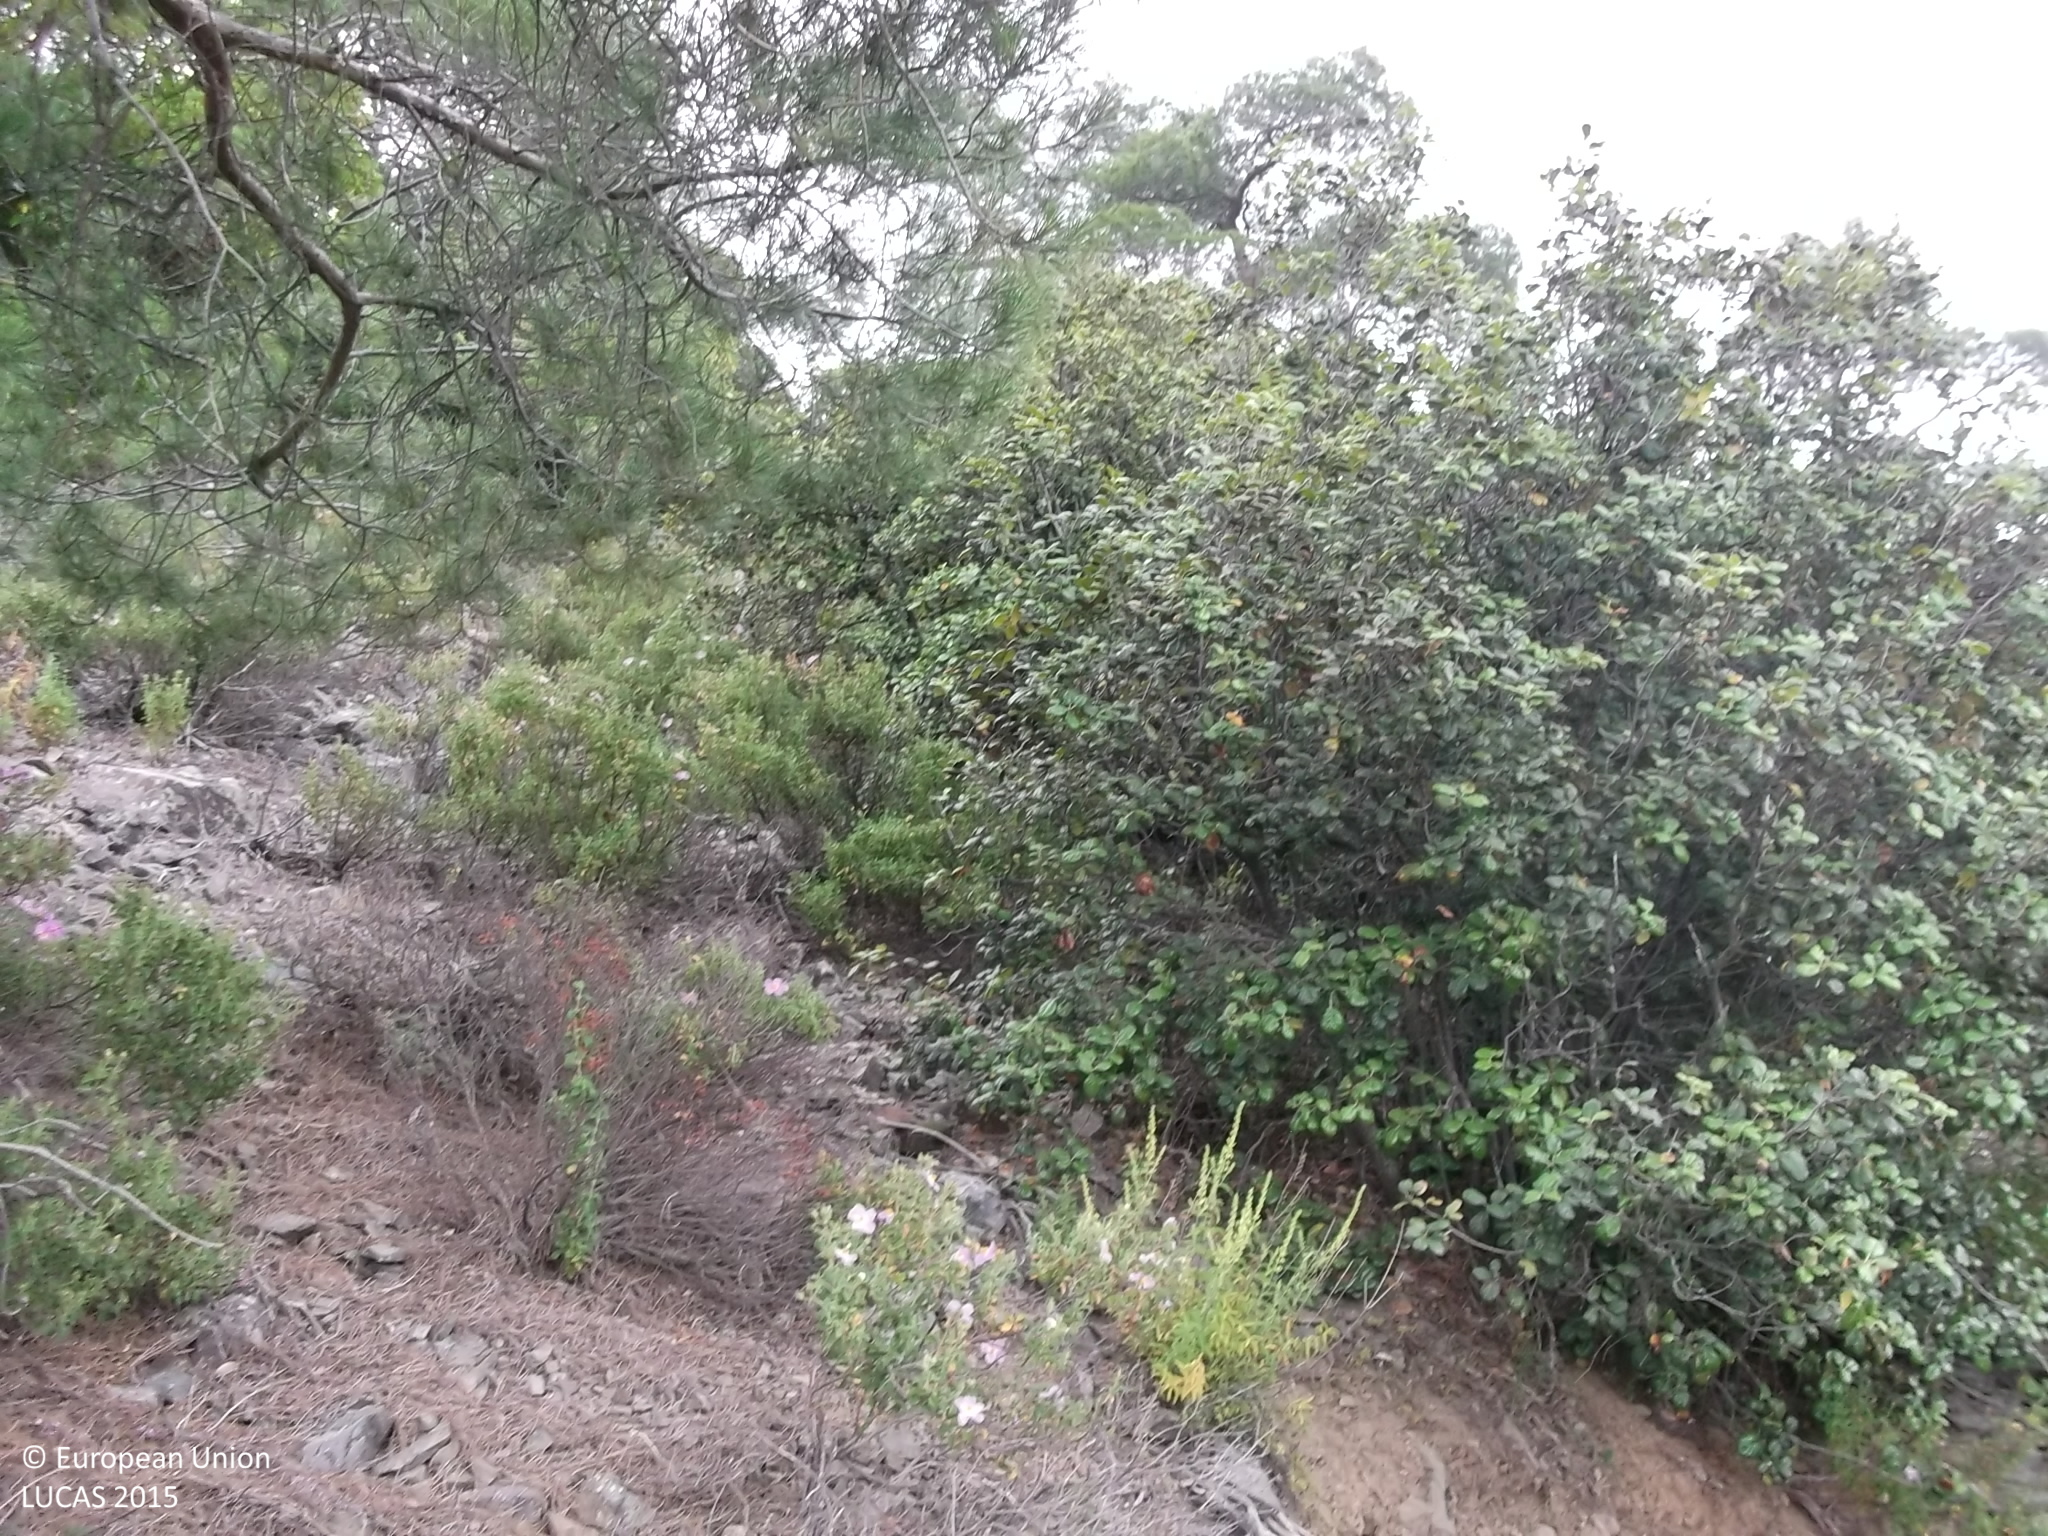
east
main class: Woodland
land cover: Pine dominated mixed woodland
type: coniferous forest of the mediterranean region
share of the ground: > 75 %
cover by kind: coniferous forest trees 60 %, broadleaved forest trees 20 %, shrubs 10 %, unconsolidated bare surface 10 %
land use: Forestry
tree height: > 5 m
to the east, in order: Pine dominated mixed woodland; Rivers and streams; Pine dominated mixed woodland; Paved roads, cycling and walking lanes; Pine dominated mixed woodland
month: June
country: CY
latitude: 34.9664
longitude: 32.9858
